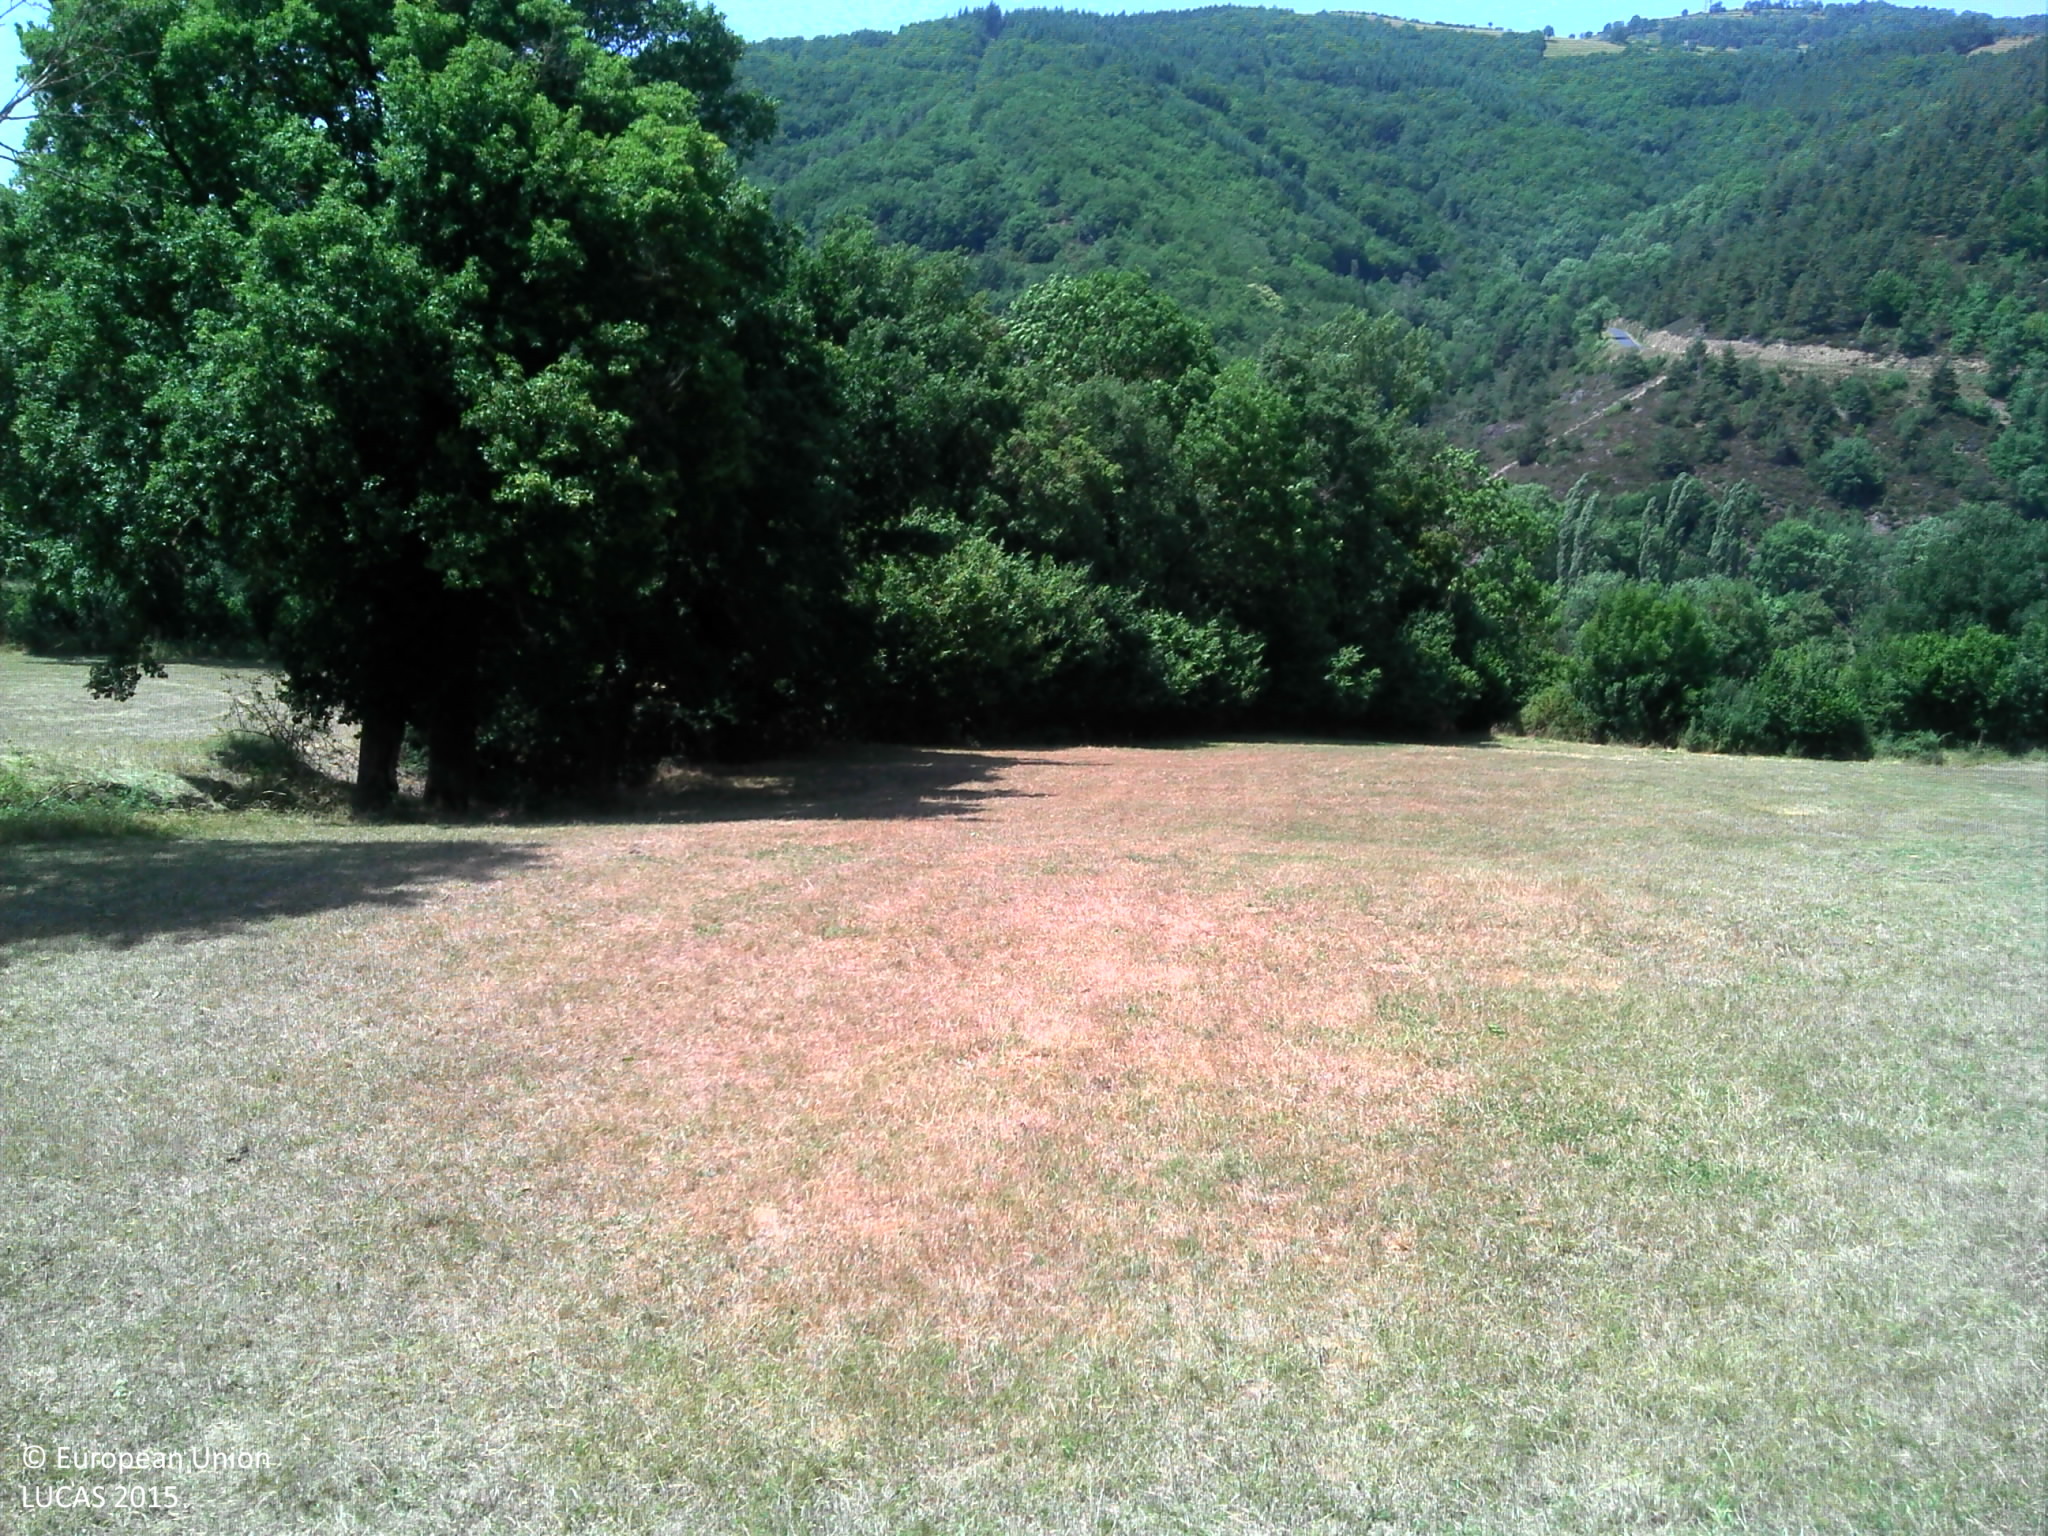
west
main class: Grassland
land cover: Grassland without tree/shrub cover
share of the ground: > 75 %
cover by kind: herbaceous plants 100 %
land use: Agriculture (excluding fallow land and kitchen gardens)
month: July
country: FR
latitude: 45.2104
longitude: 3.1645
